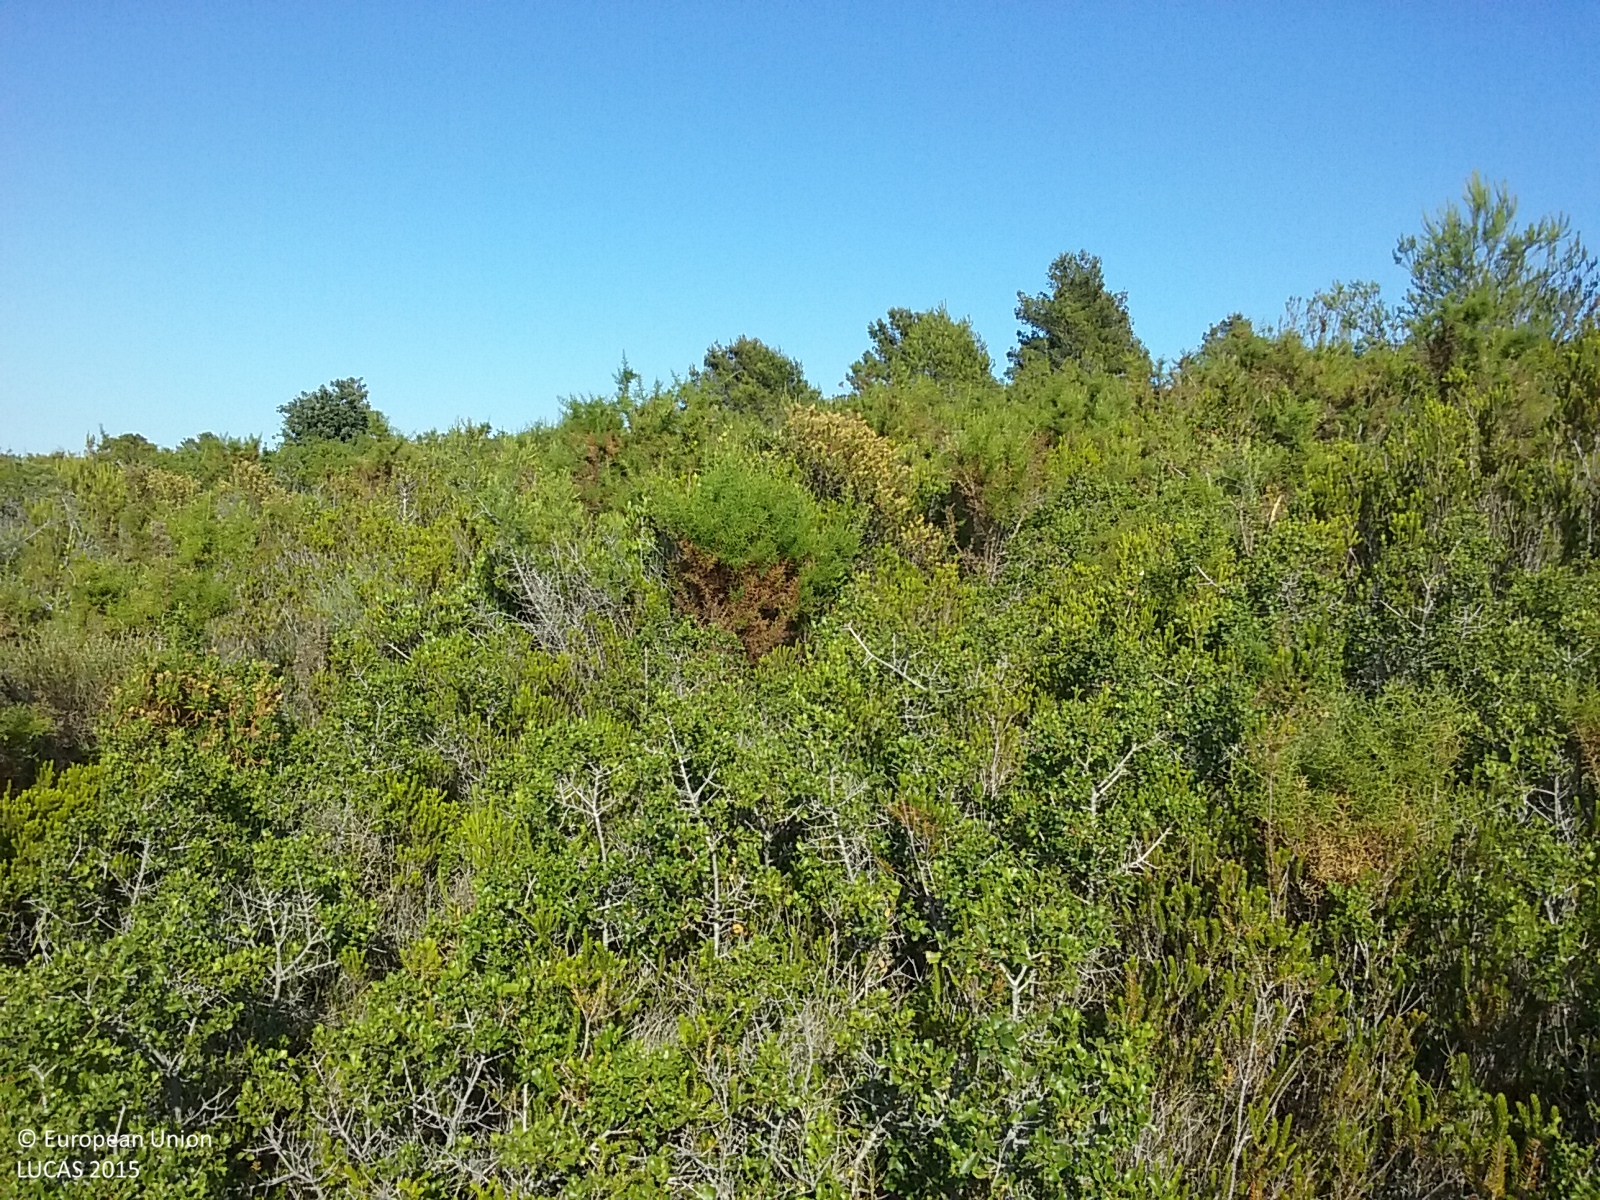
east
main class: Shrubland
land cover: Shrubland with sparse tree cover
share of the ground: > 75 %
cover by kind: shrubs 90 %, coniferous forest trees 5 %, herbaceous plants 5 %
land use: Semi-natural and natural areas not in use
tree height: < 5 m
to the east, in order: Shrubland with sparse tree cover; Tracks; Olive groves; Artificial constructions in urban areas; Dry stone walls; Olive groves; Dry stone walls; Shrubland with sparse tree cover; Dry stone walls; Shrubland with sparse tree cover; Dry stone walls; Pine dominated coniferous woodland; Dry stone walls; Pine dominated coniferous woodland
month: June
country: ES
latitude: 40.1864
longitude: 0.1200
